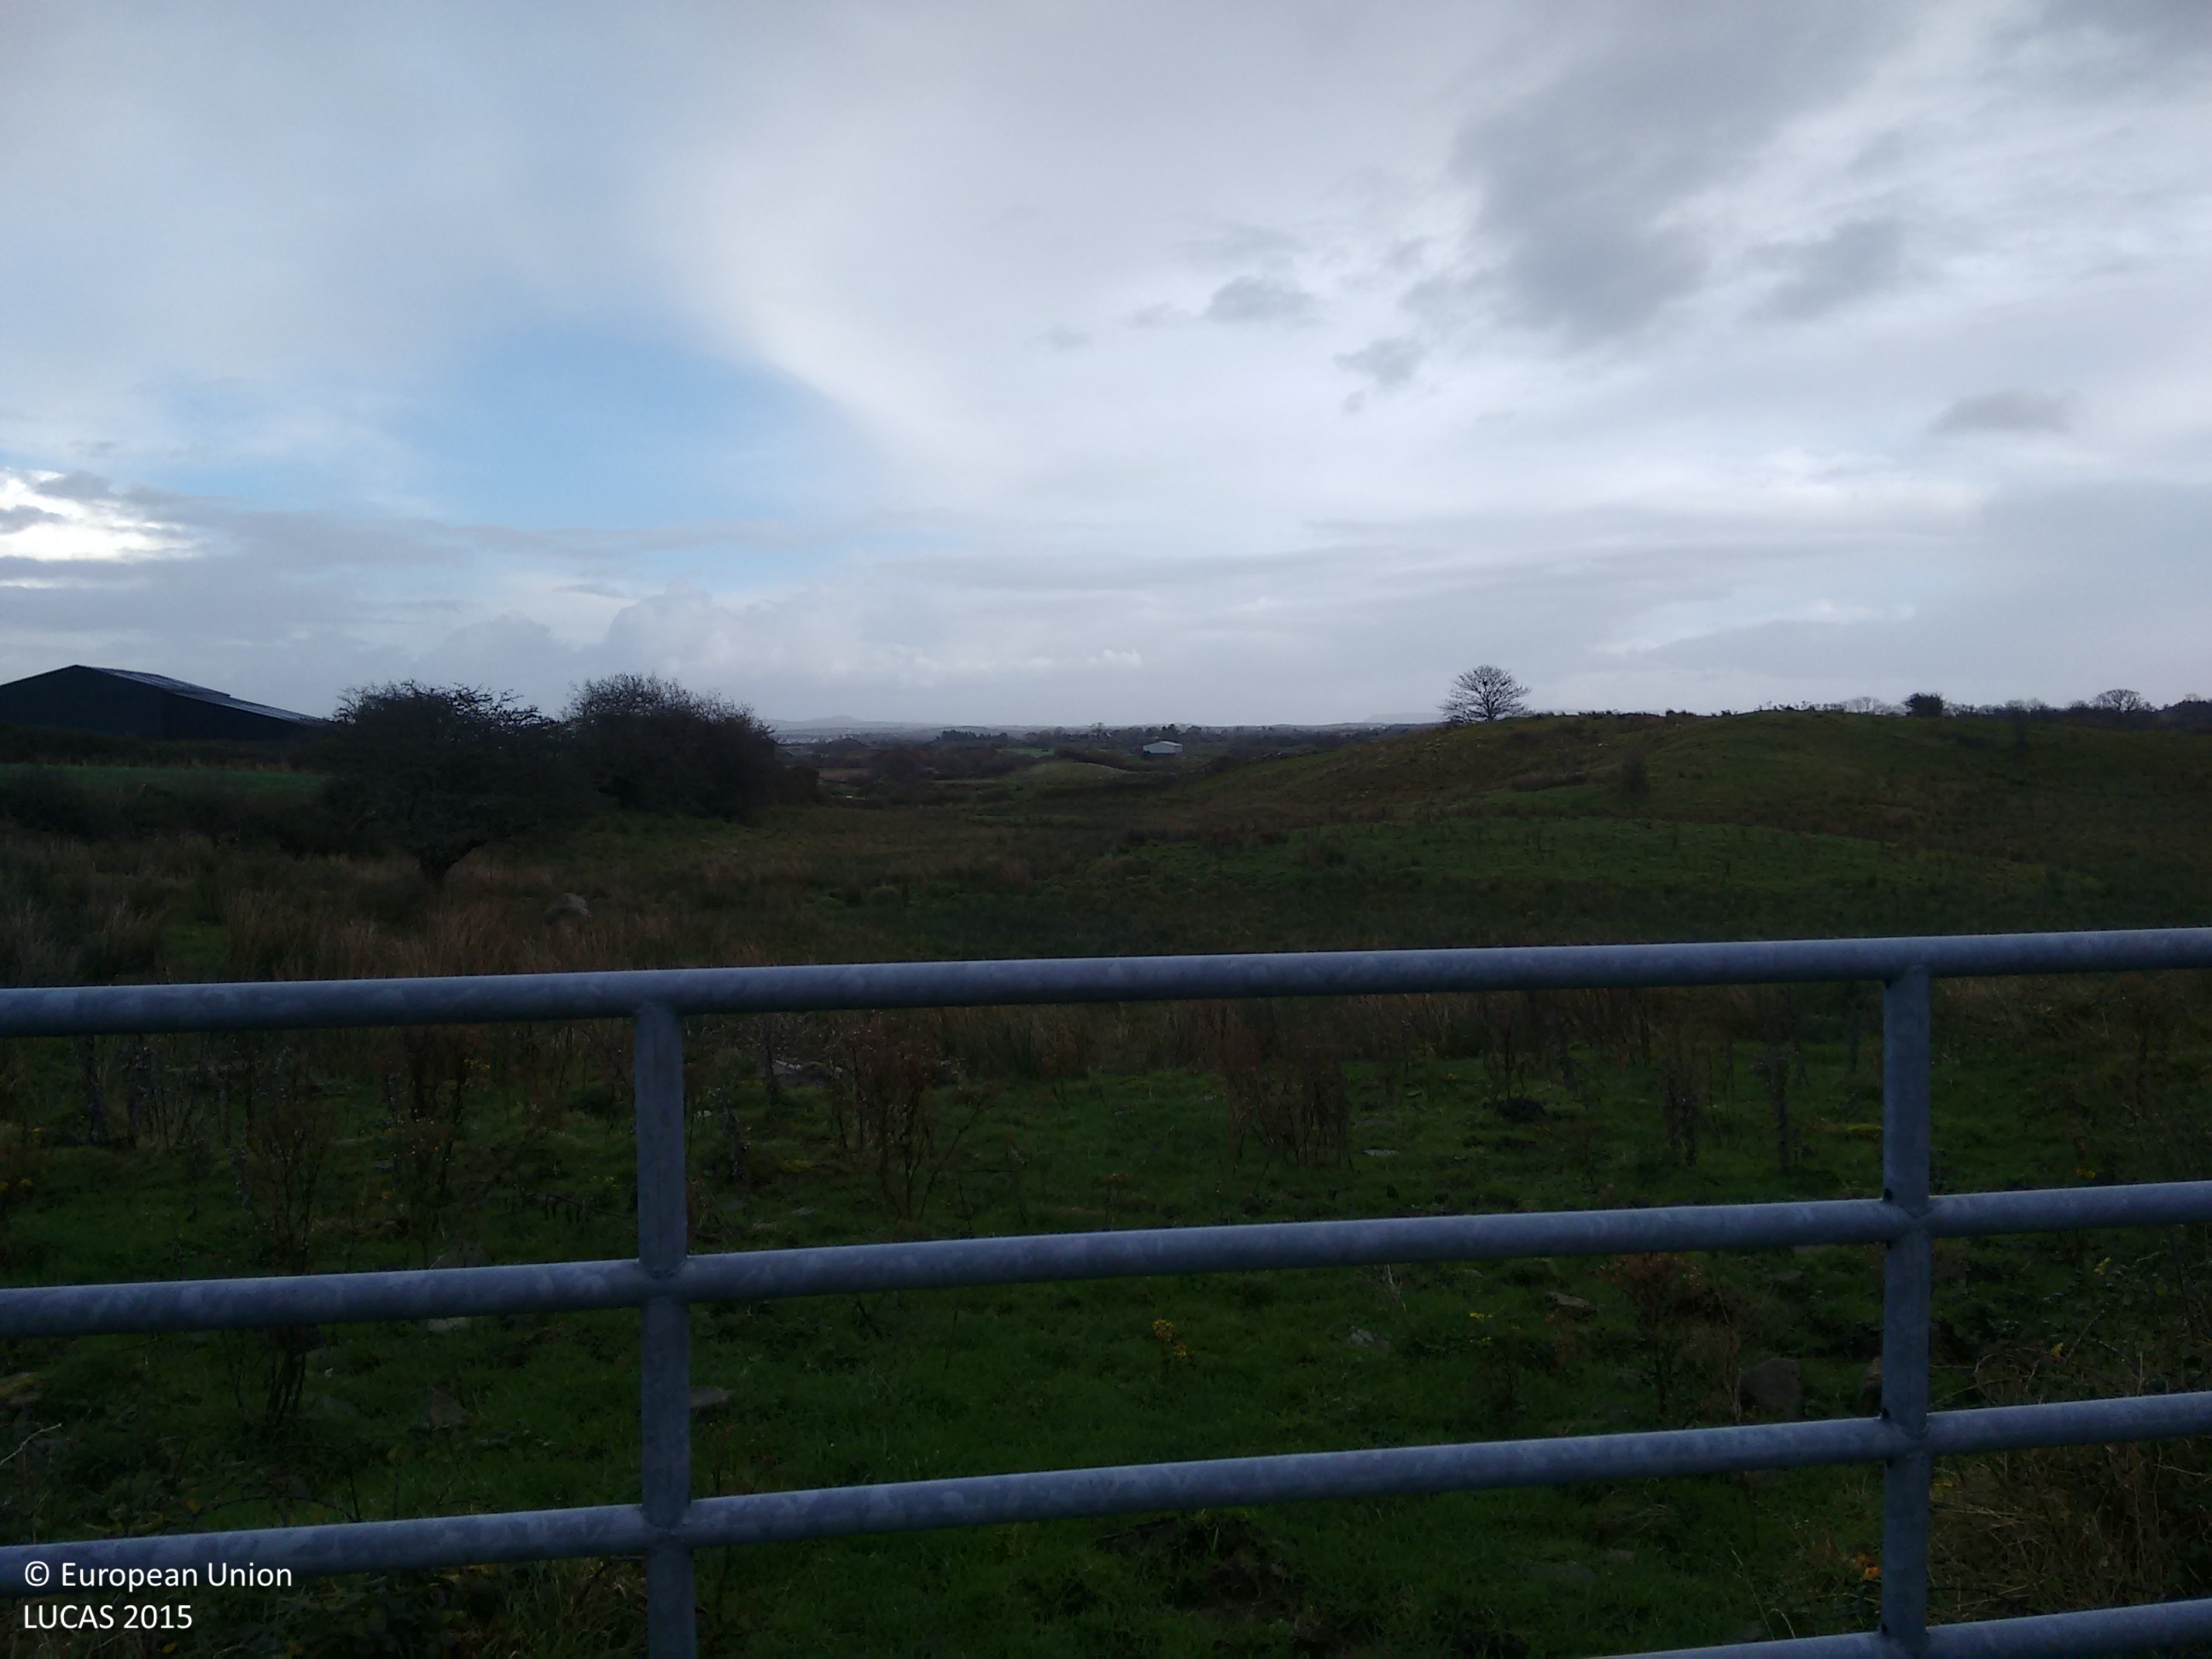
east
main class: Grassland
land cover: Grassland without tree/shrub cover
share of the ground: > 75 %
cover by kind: herbaceous plants 100 %
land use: Agriculture (excluding fallow land and kitchen gardens)
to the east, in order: Grassland without tree/shrub cover; Dry stone walls; Abandoned hedges; Grassland without tree/shrub cover; Dry stone walls; Tracks; Dry stone walls; Grassland without tree/shrub cover
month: November
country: IE
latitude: 54.4590
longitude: -8.3417
